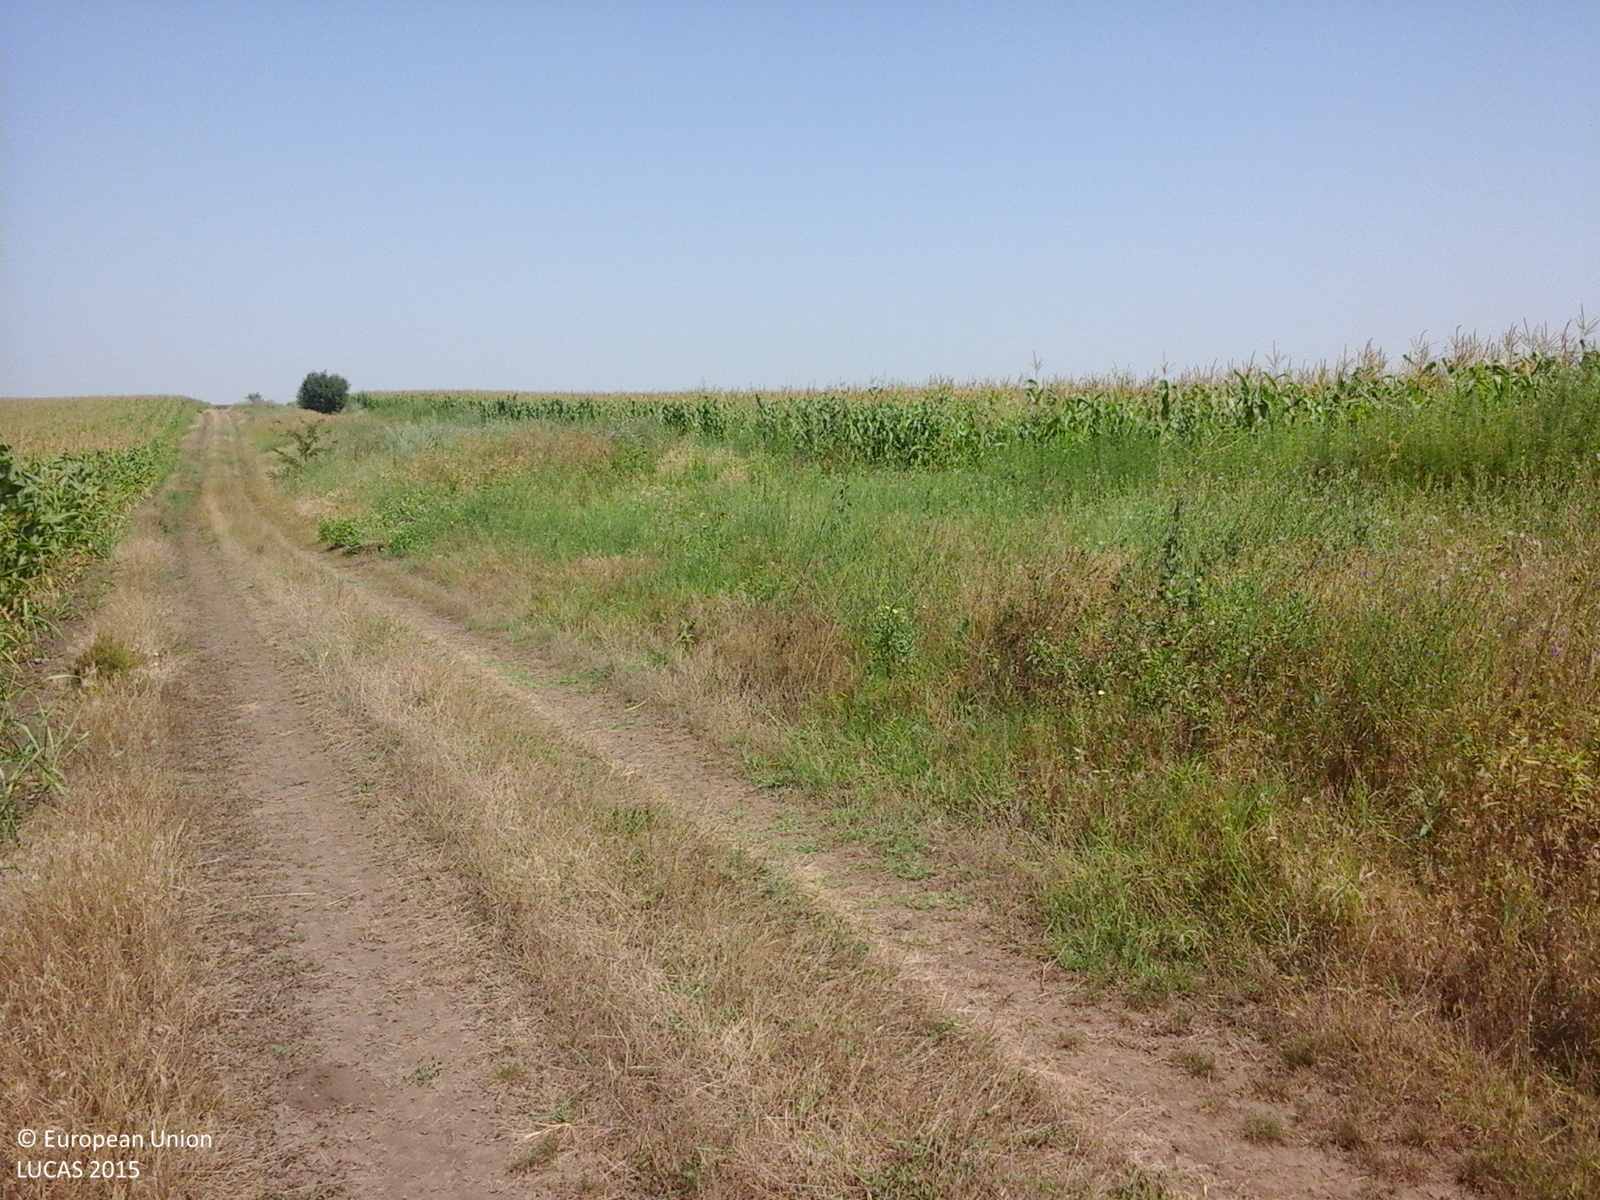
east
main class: Cropland
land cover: Maize
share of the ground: > 75 %
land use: Agriculture (excluding fallow land and kitchen gardens)
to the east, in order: Maize
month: July
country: RO
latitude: 44.2738
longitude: 27.0283
